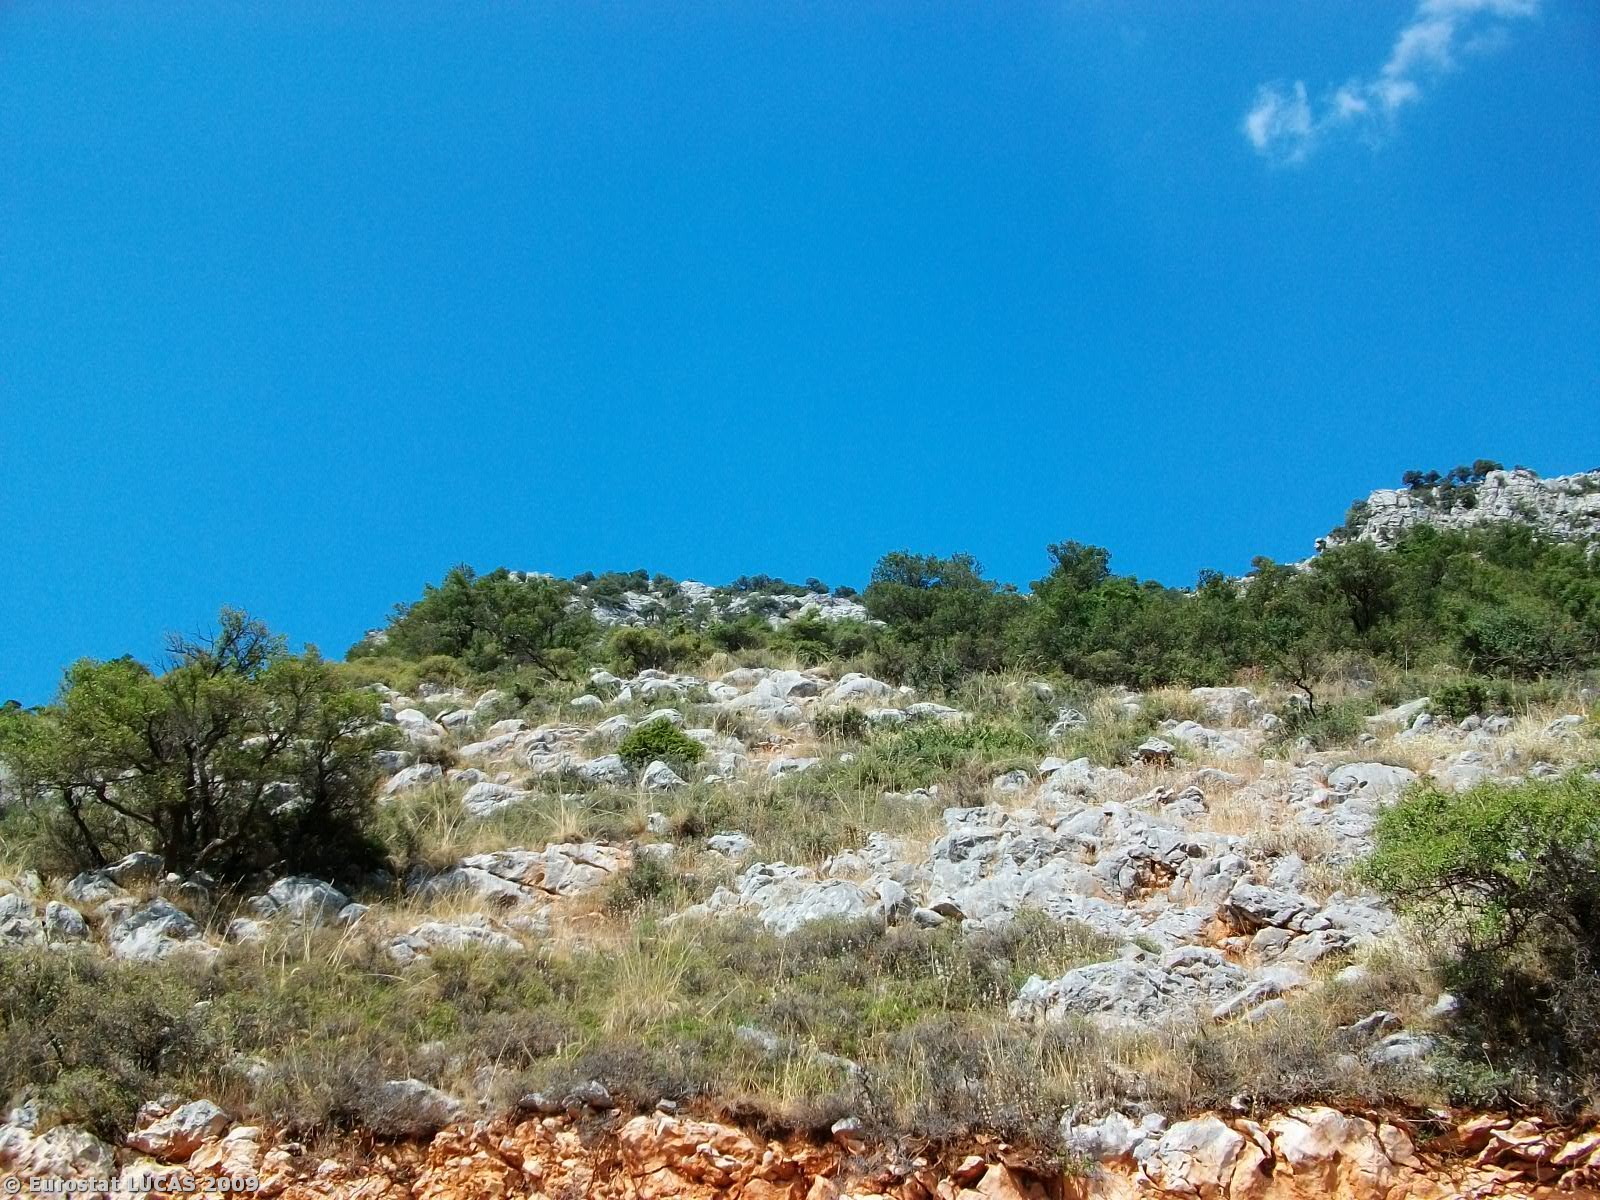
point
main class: Shrubland
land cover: Shrubland with sparse tree cover
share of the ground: 50 - 75 %
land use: Unused
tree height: > 5 m
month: August
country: GR
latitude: 38.6543
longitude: 22.3990
